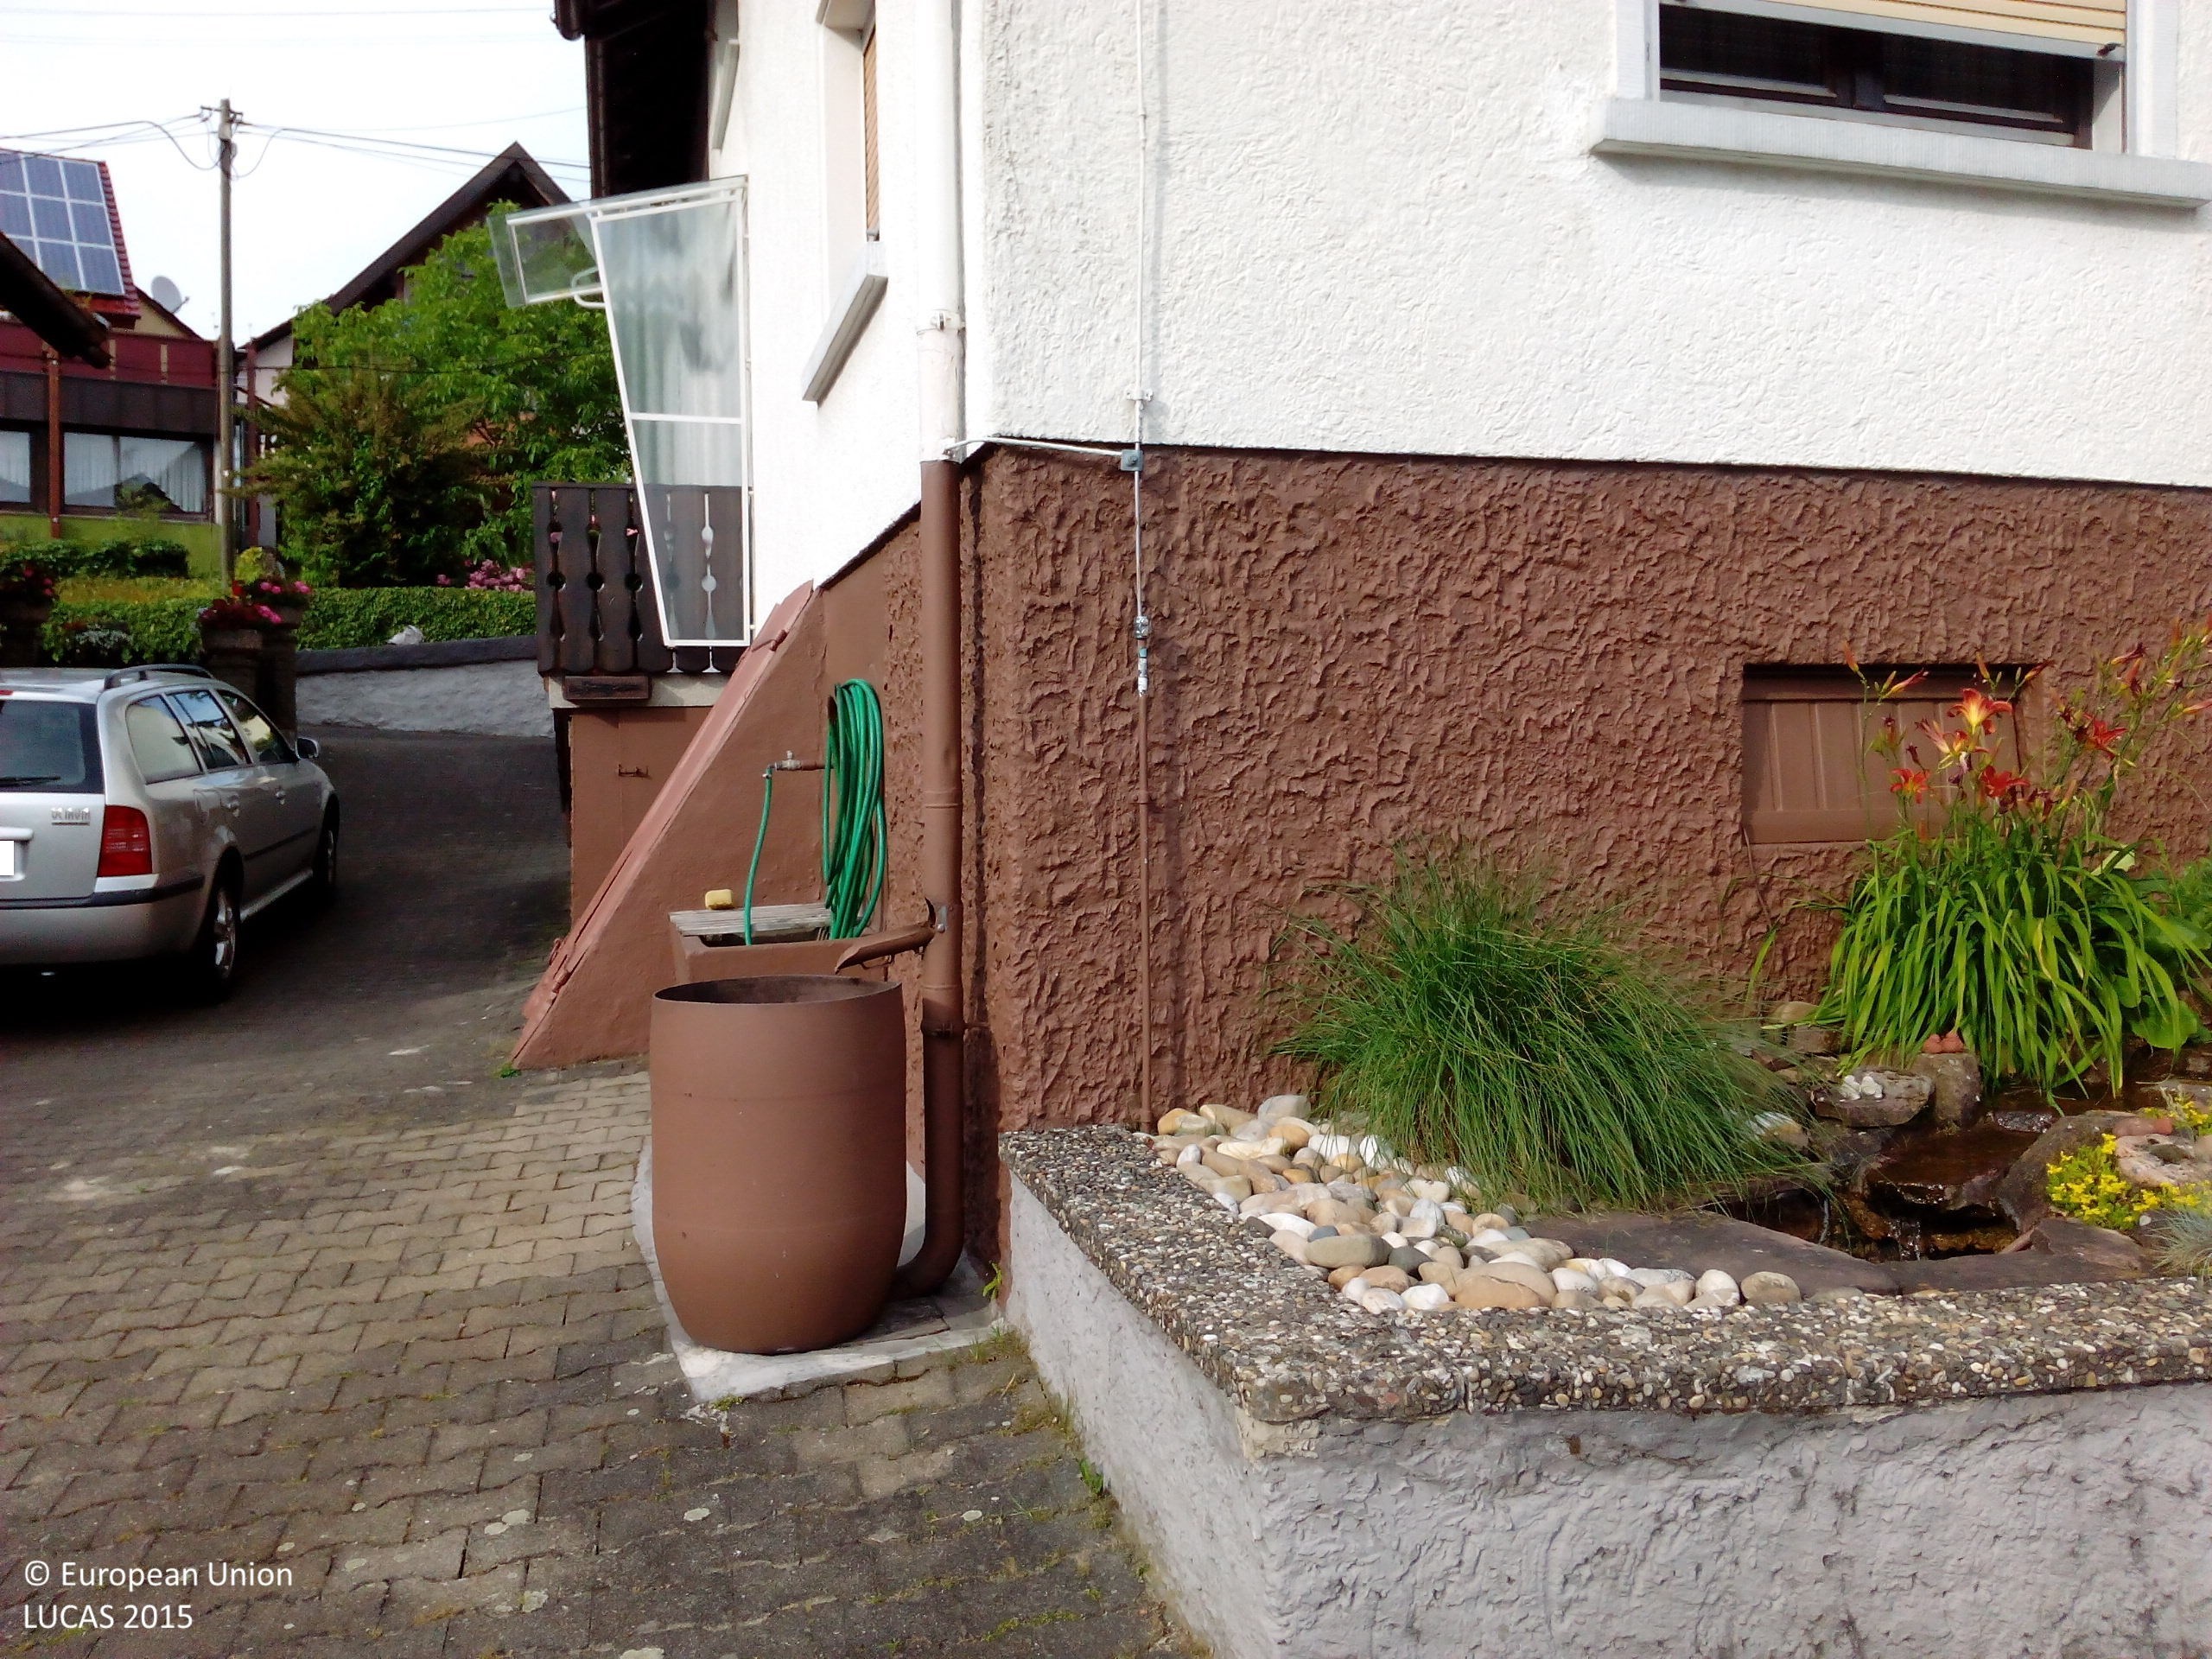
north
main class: Grassland
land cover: Grassland without tree/shrub cover
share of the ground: > 75 %
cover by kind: herbaceous plants 100 %
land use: Residential
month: June
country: DE
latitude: 48.7122
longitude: 8.1660
